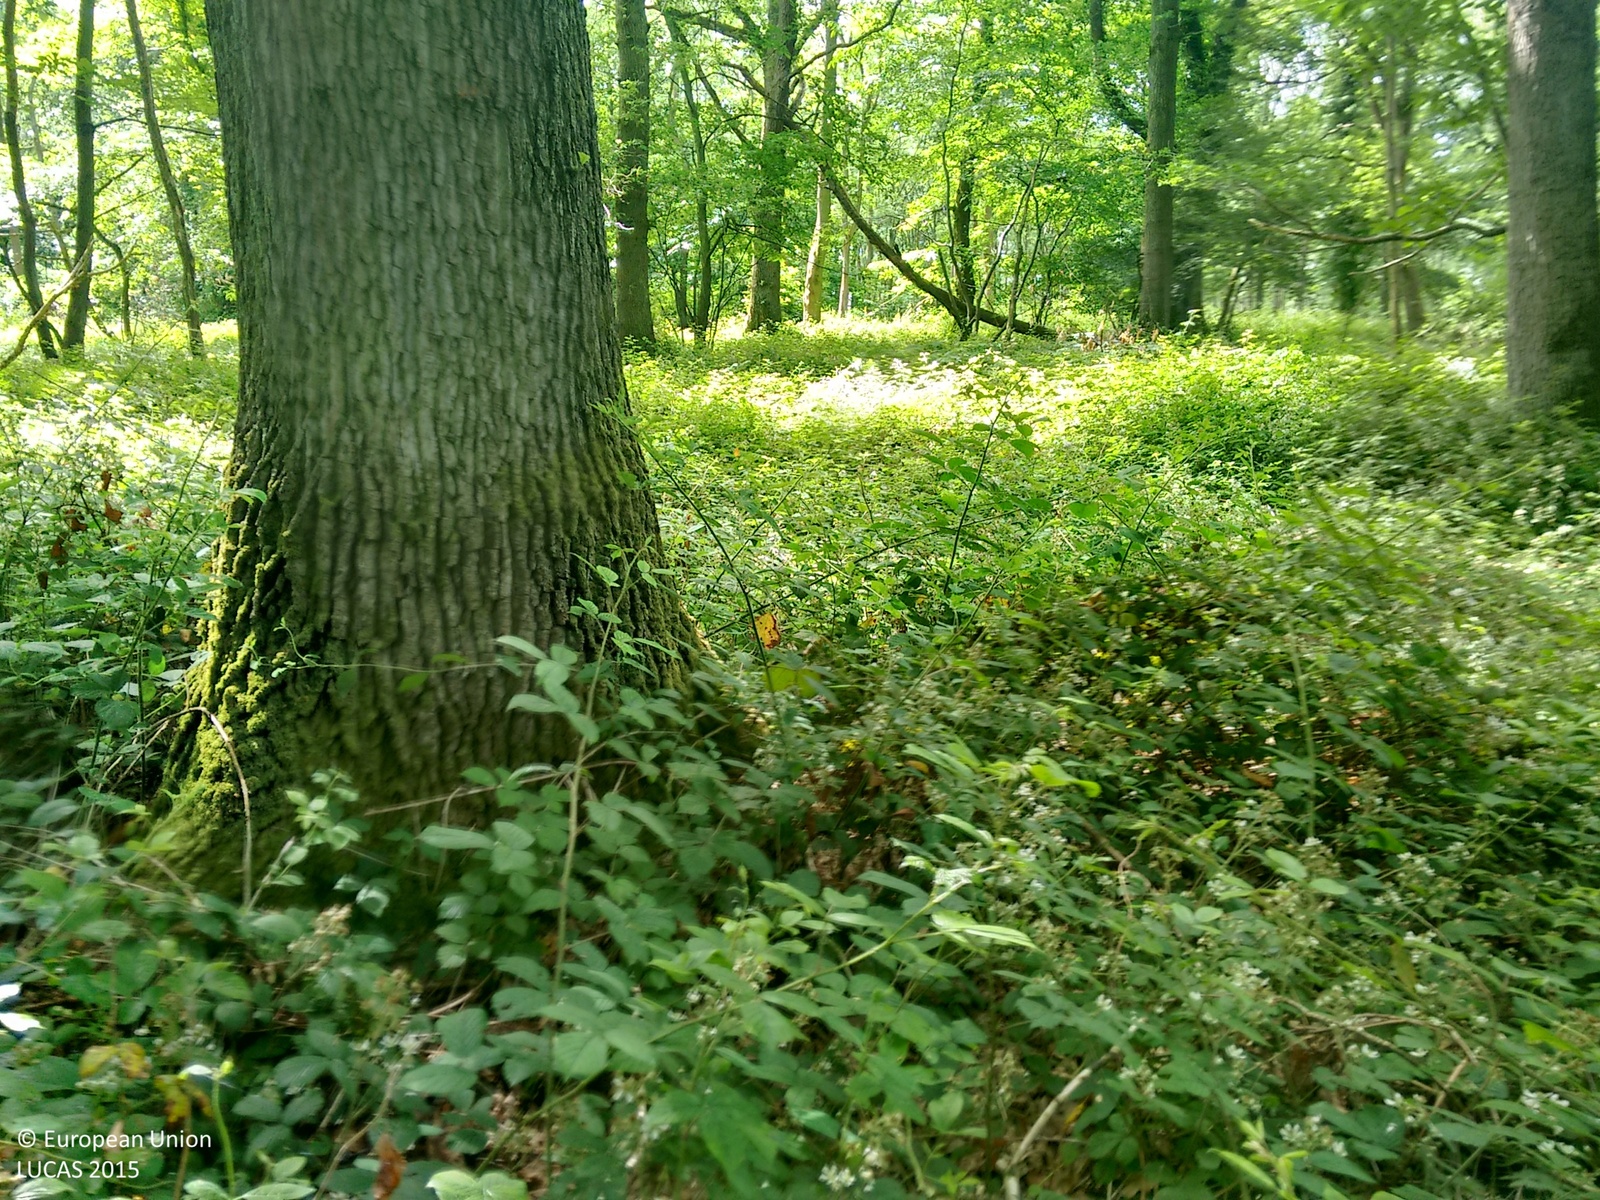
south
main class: Woodland
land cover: Broadleaved woodland
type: mesophytic deciduous forest
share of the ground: > 75 %
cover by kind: broadleaved forest trees 95 %, shrubs 5 %
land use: Semi-natural and natural areas not in use
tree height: > 5 m
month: July
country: GB
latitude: 52.1636
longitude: -2.7157
